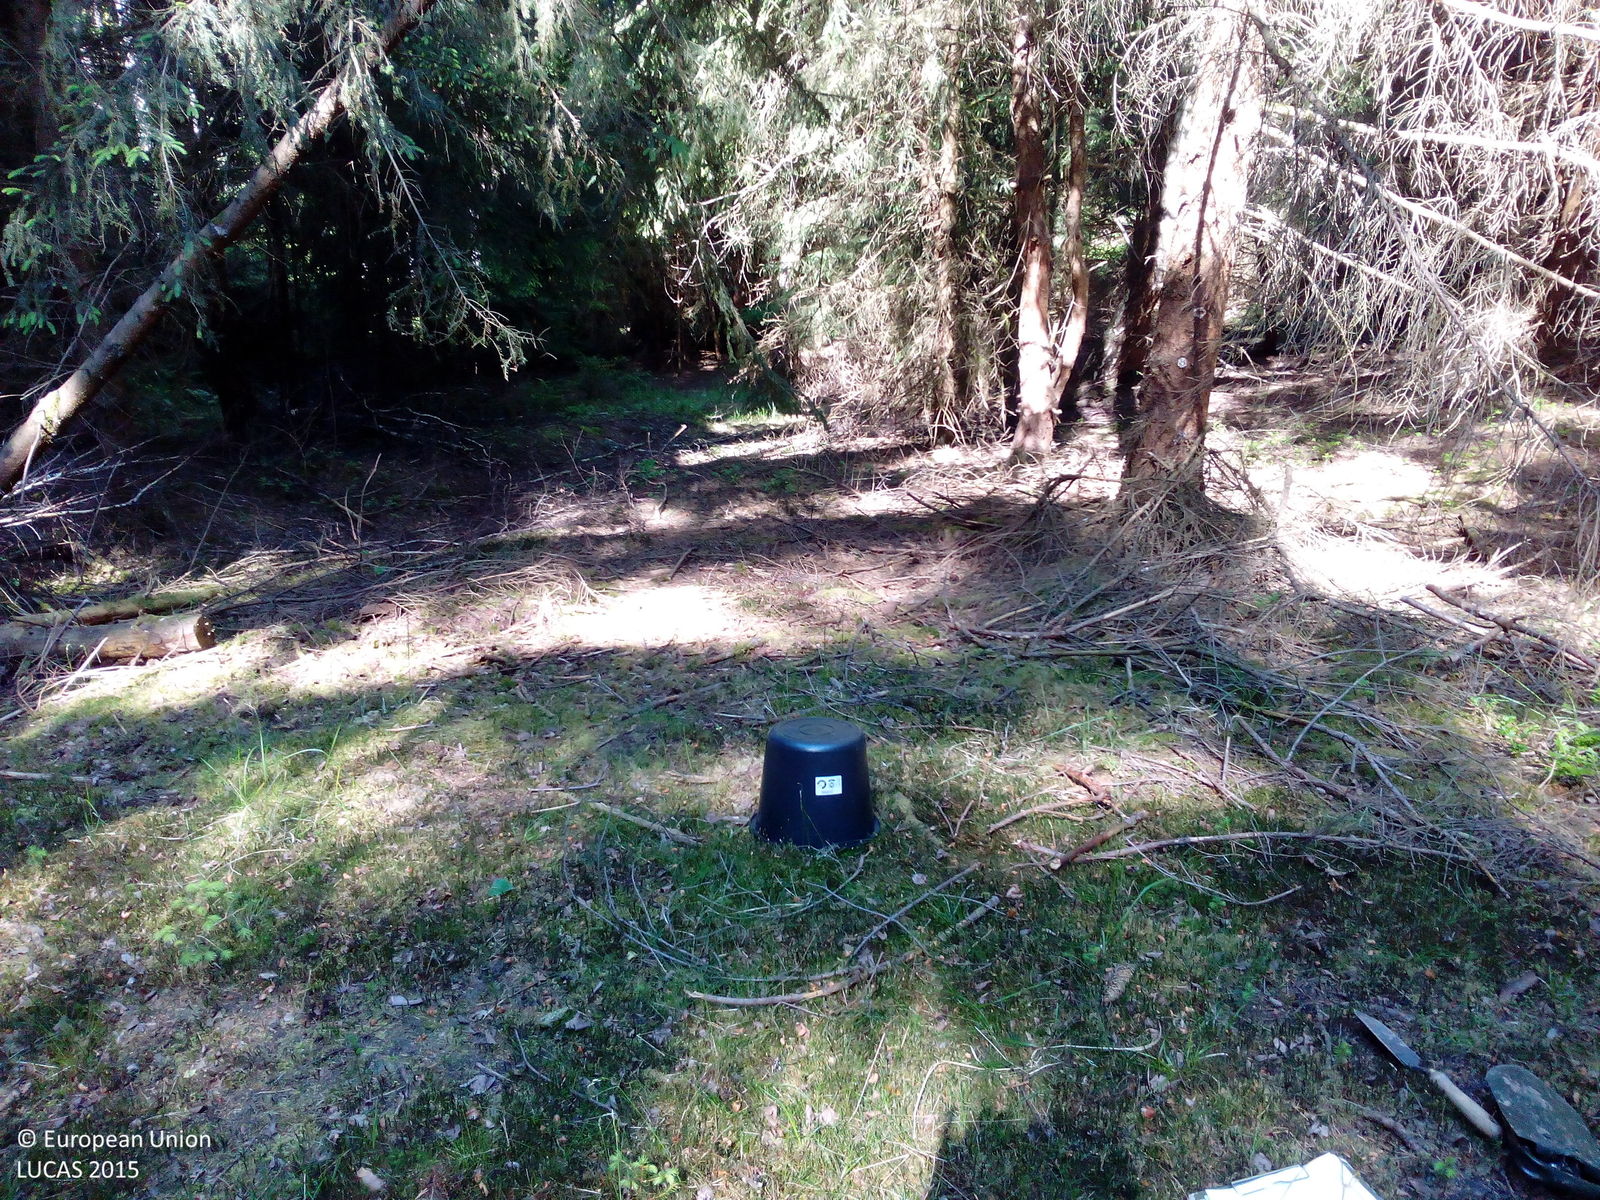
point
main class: Woodland
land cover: Spruce dominated coniferous woodland
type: hemiboreal forest and nemoral coniferous forest and mixed broadleaved-coniferous forest
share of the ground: > 75 %
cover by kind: coniferous forest trees 90 %, lichens and mosses 10 %
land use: Forestry
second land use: Amenities, museums, leisure
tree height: > 5 m
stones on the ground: < 10 %
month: June
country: DE
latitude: 50.8196
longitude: 11.6604
